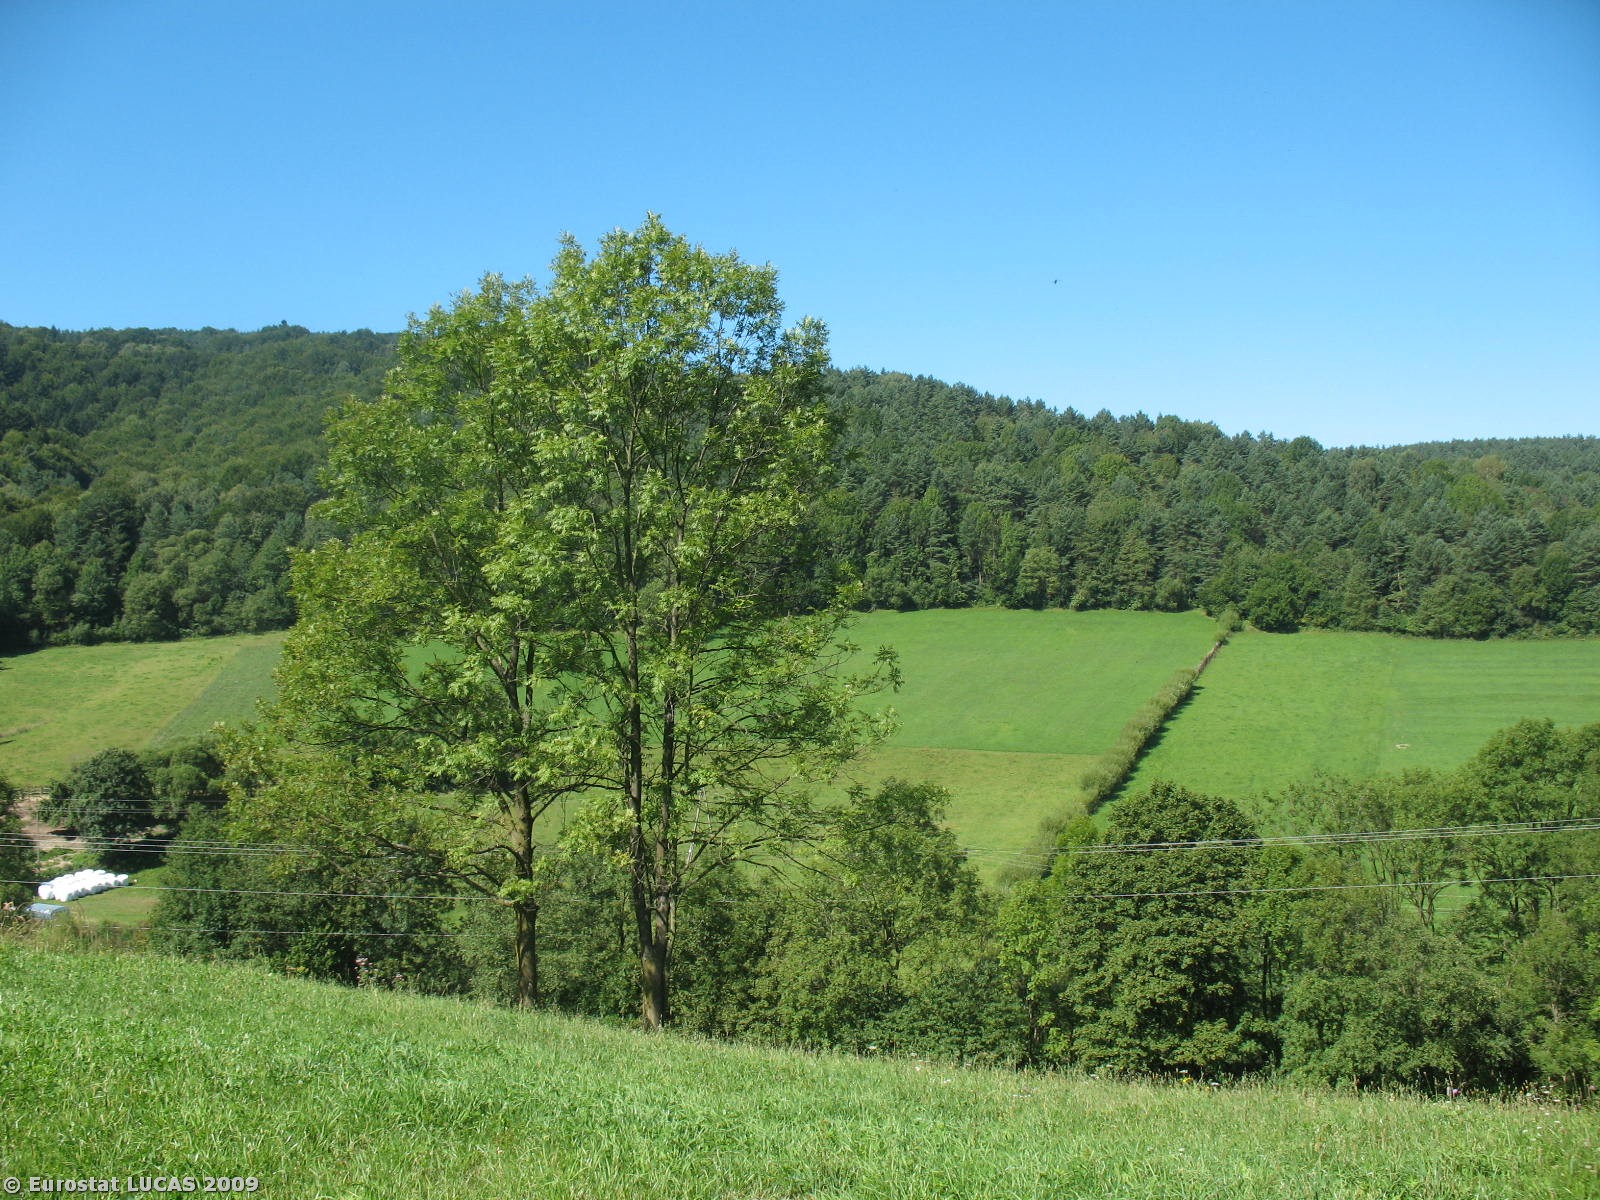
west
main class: Grassland
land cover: Grassland without tree/shrub cover
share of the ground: > 75 %
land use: Agriculture (excluding fallow land and kitchen gardens)
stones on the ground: < 10 %
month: August
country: PL
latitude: 49.3812
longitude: 22.1947
